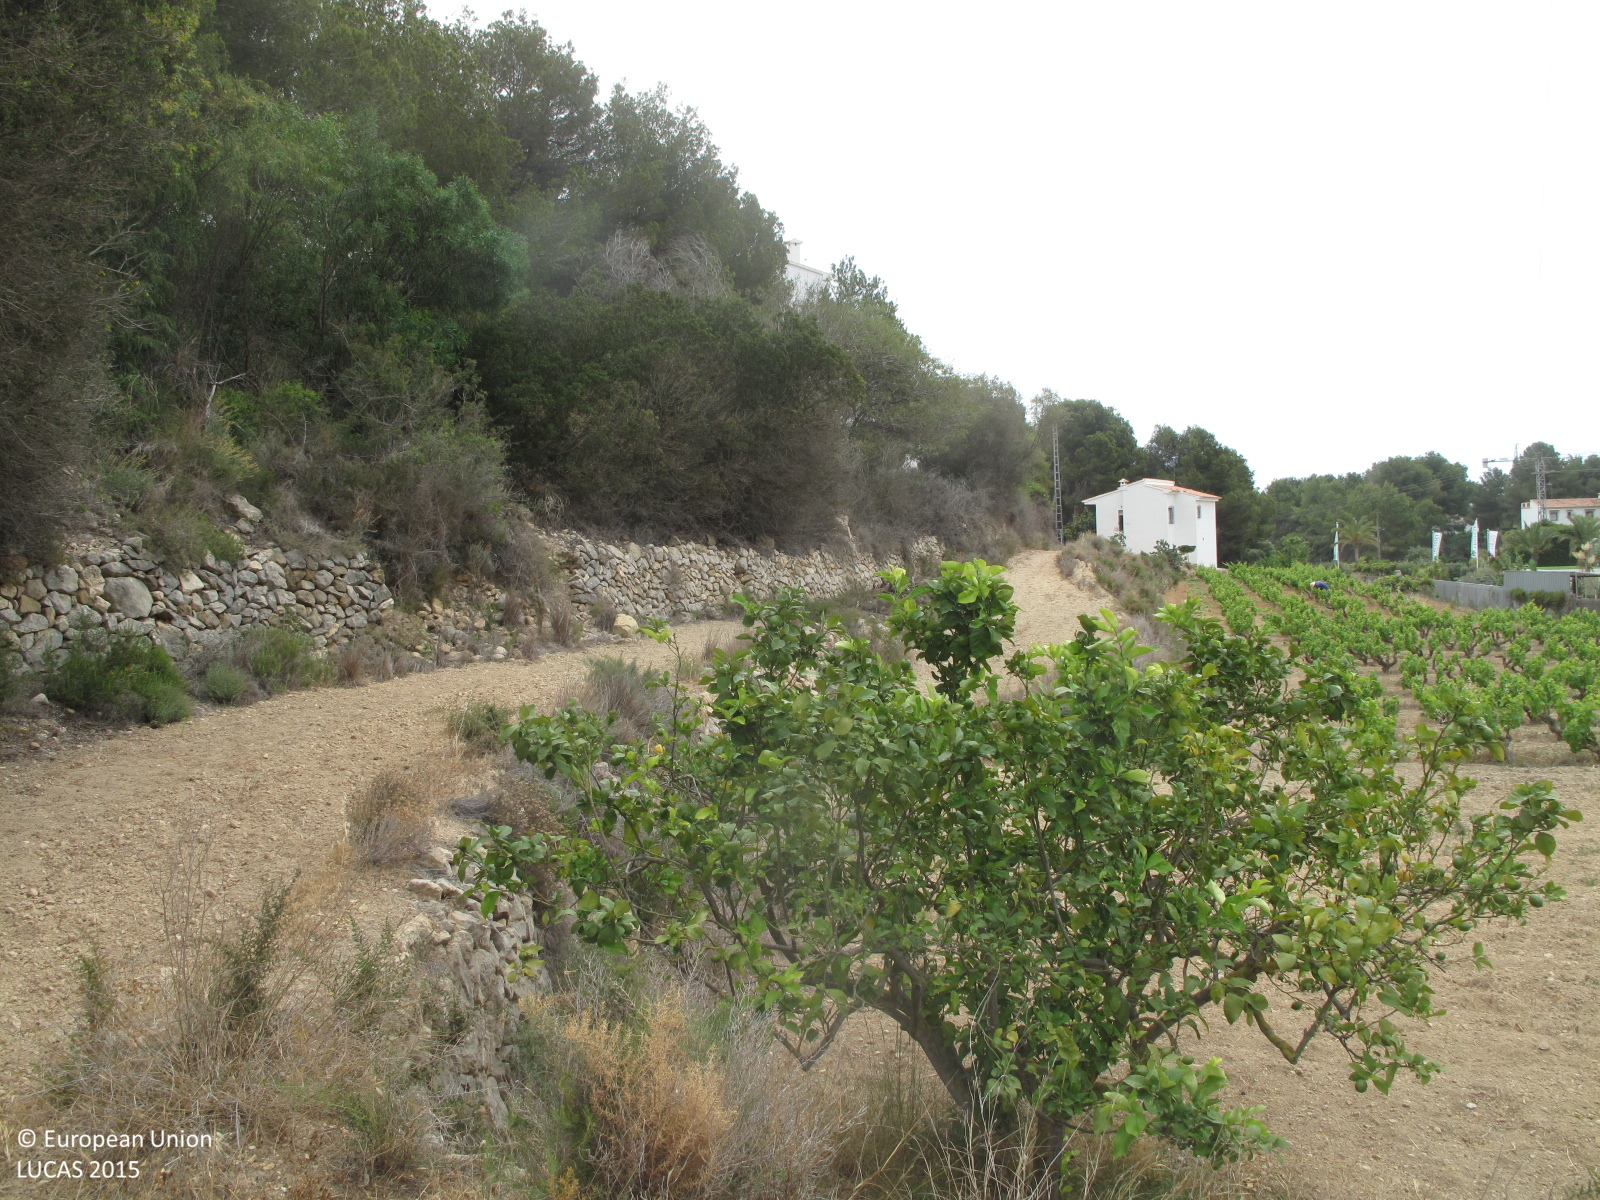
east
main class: Cropland
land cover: Vineyards
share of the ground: 10 - 25 %
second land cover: Other bare soil
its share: > 75 %
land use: Agriculture (excluding fallow land and kitchen gardens)
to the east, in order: Vineyards; Other bare soil; Tracks; Dry stone walls; Shrubland with sparse tree cover; Artificial constructions in urban areas; Single bushes/trees; Artificial constructions in urban areas; Single bushes/trees; Paved roads, cycling and walking lanes; Fences; Pine dominated coniferous woodland; Spontaneously vegetated surfaces
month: May
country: ES
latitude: 38.6913
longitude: 0.1139
